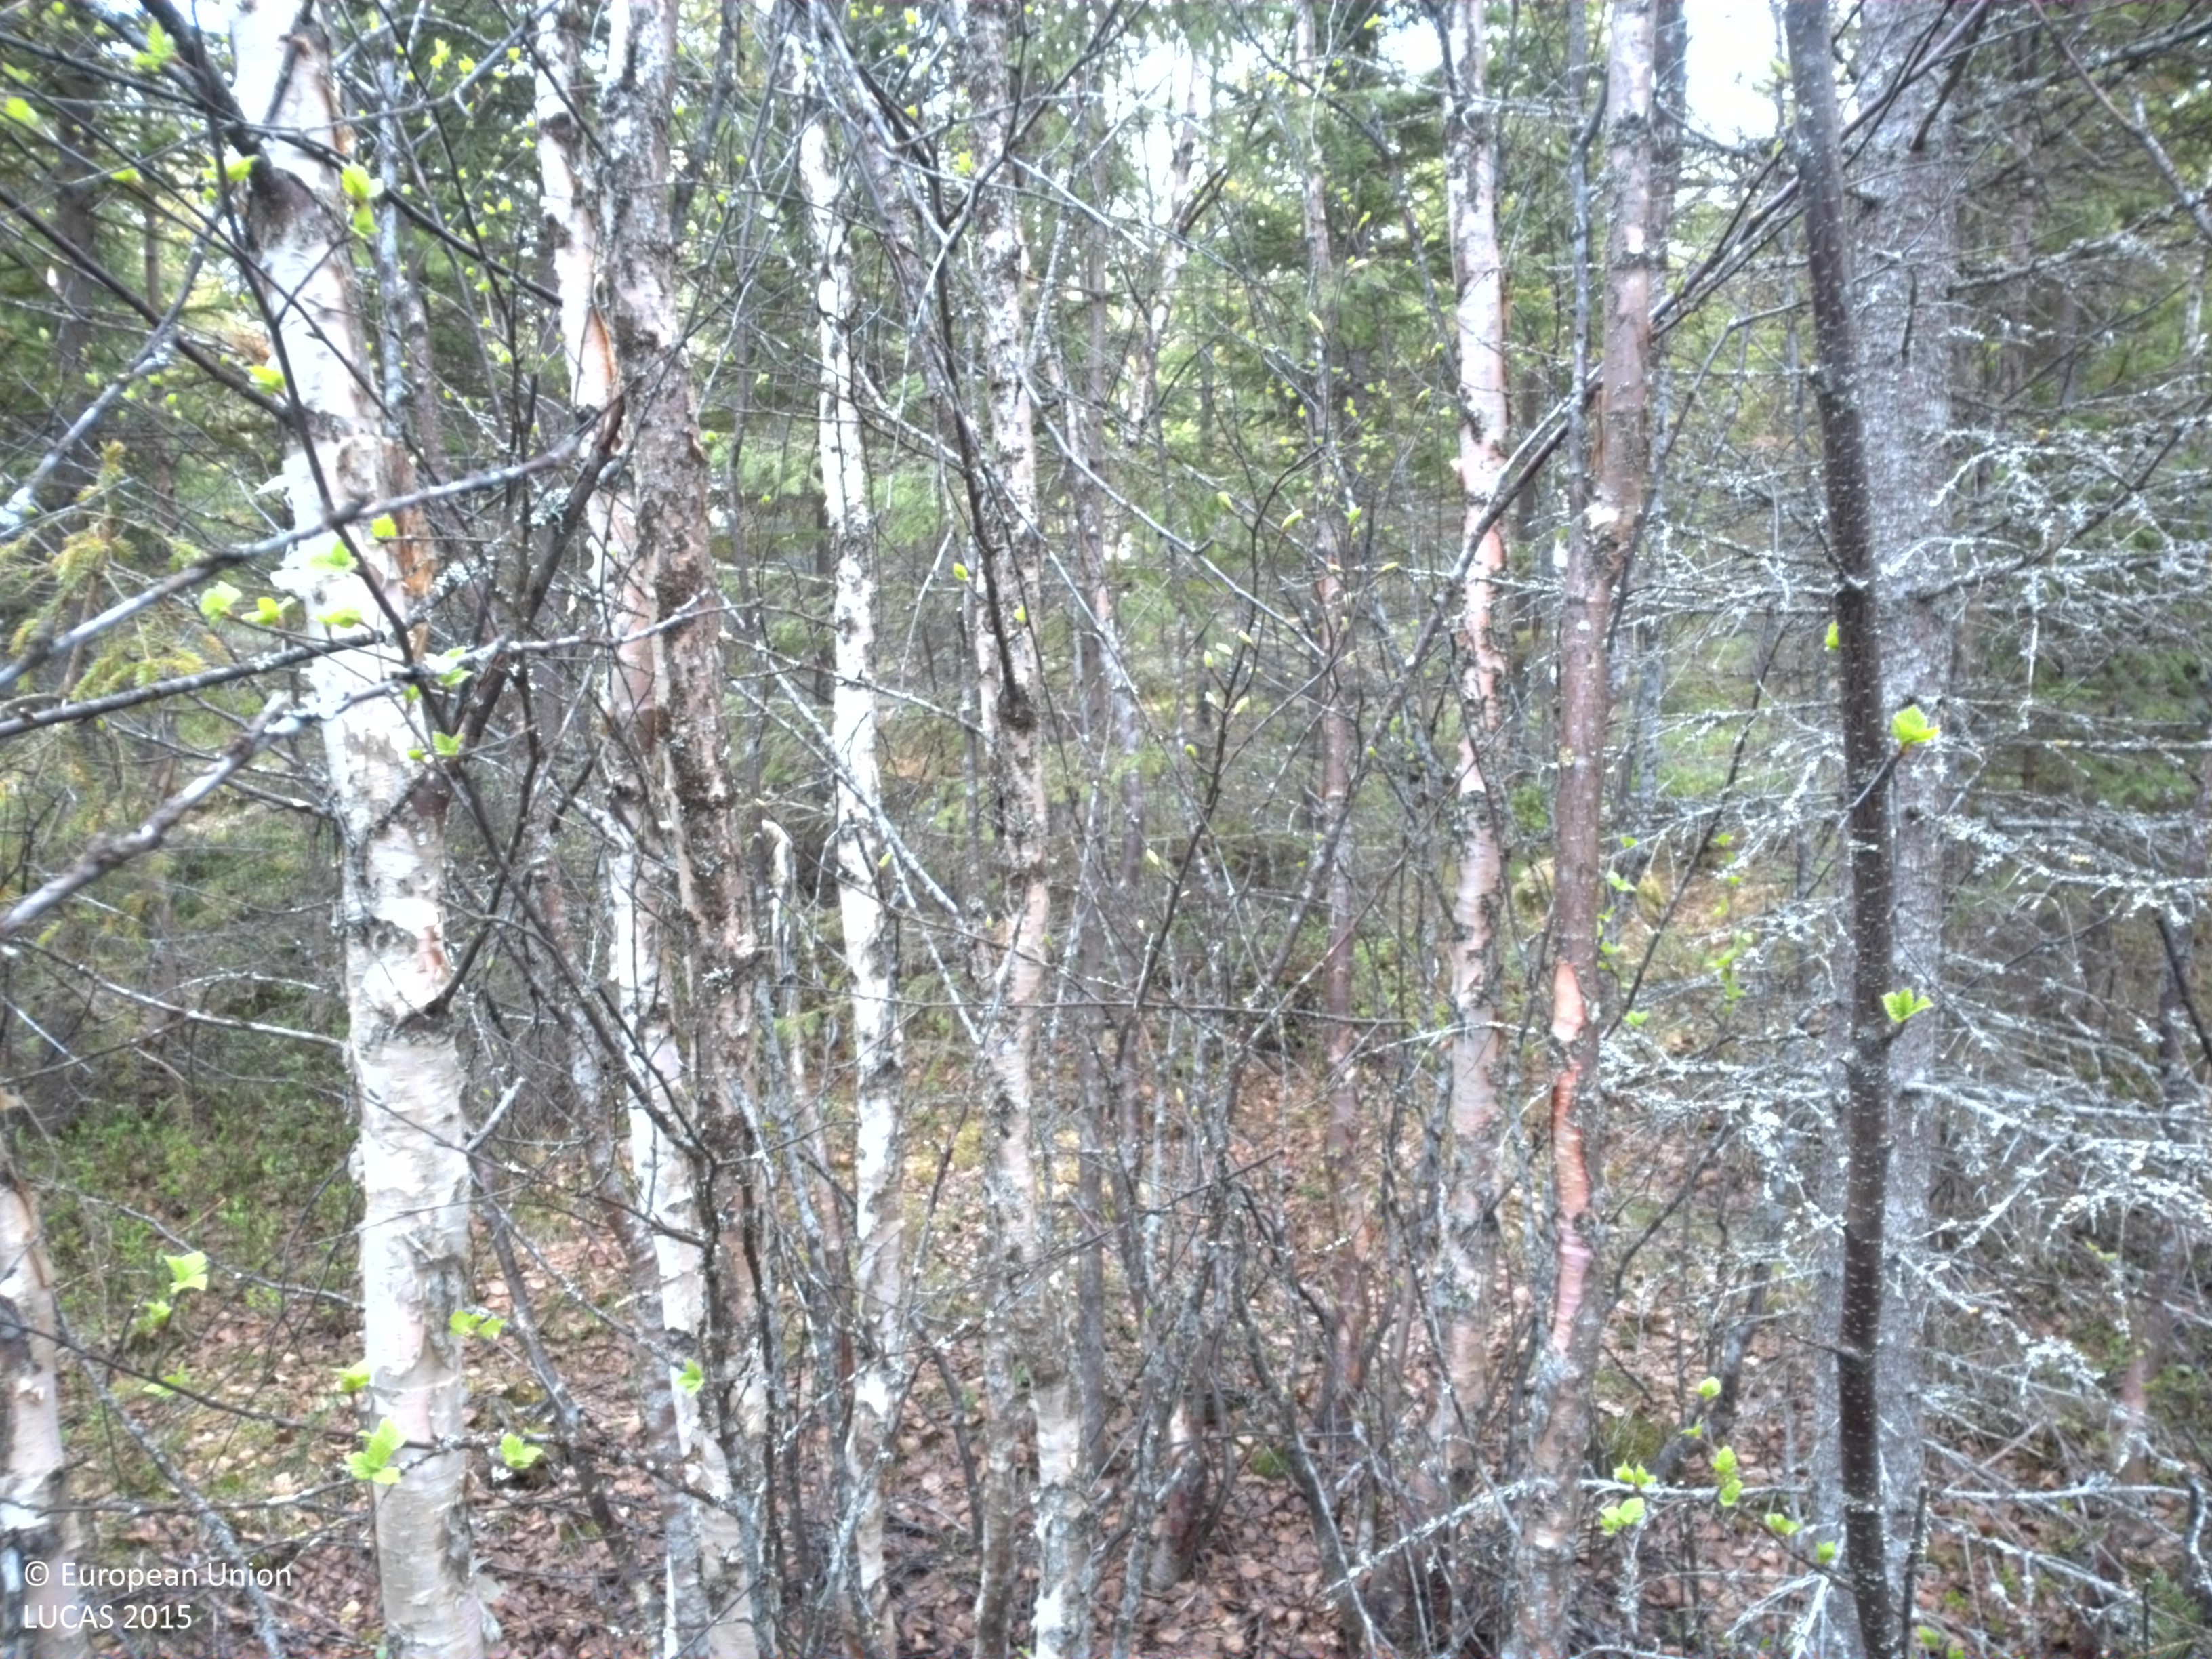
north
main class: Woodland
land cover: Spruce dominated mixed woodland
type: boreal forest
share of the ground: 50 - 75 %
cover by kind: coniferous forest trees 35 %, broadleaved forest trees 35 %, herbaceous plants 20 %, shrubs 5 %, lichens and mosses 5 %
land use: Forestry
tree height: > 5 m
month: June
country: SE
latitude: 64.3680
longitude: 18.1941
